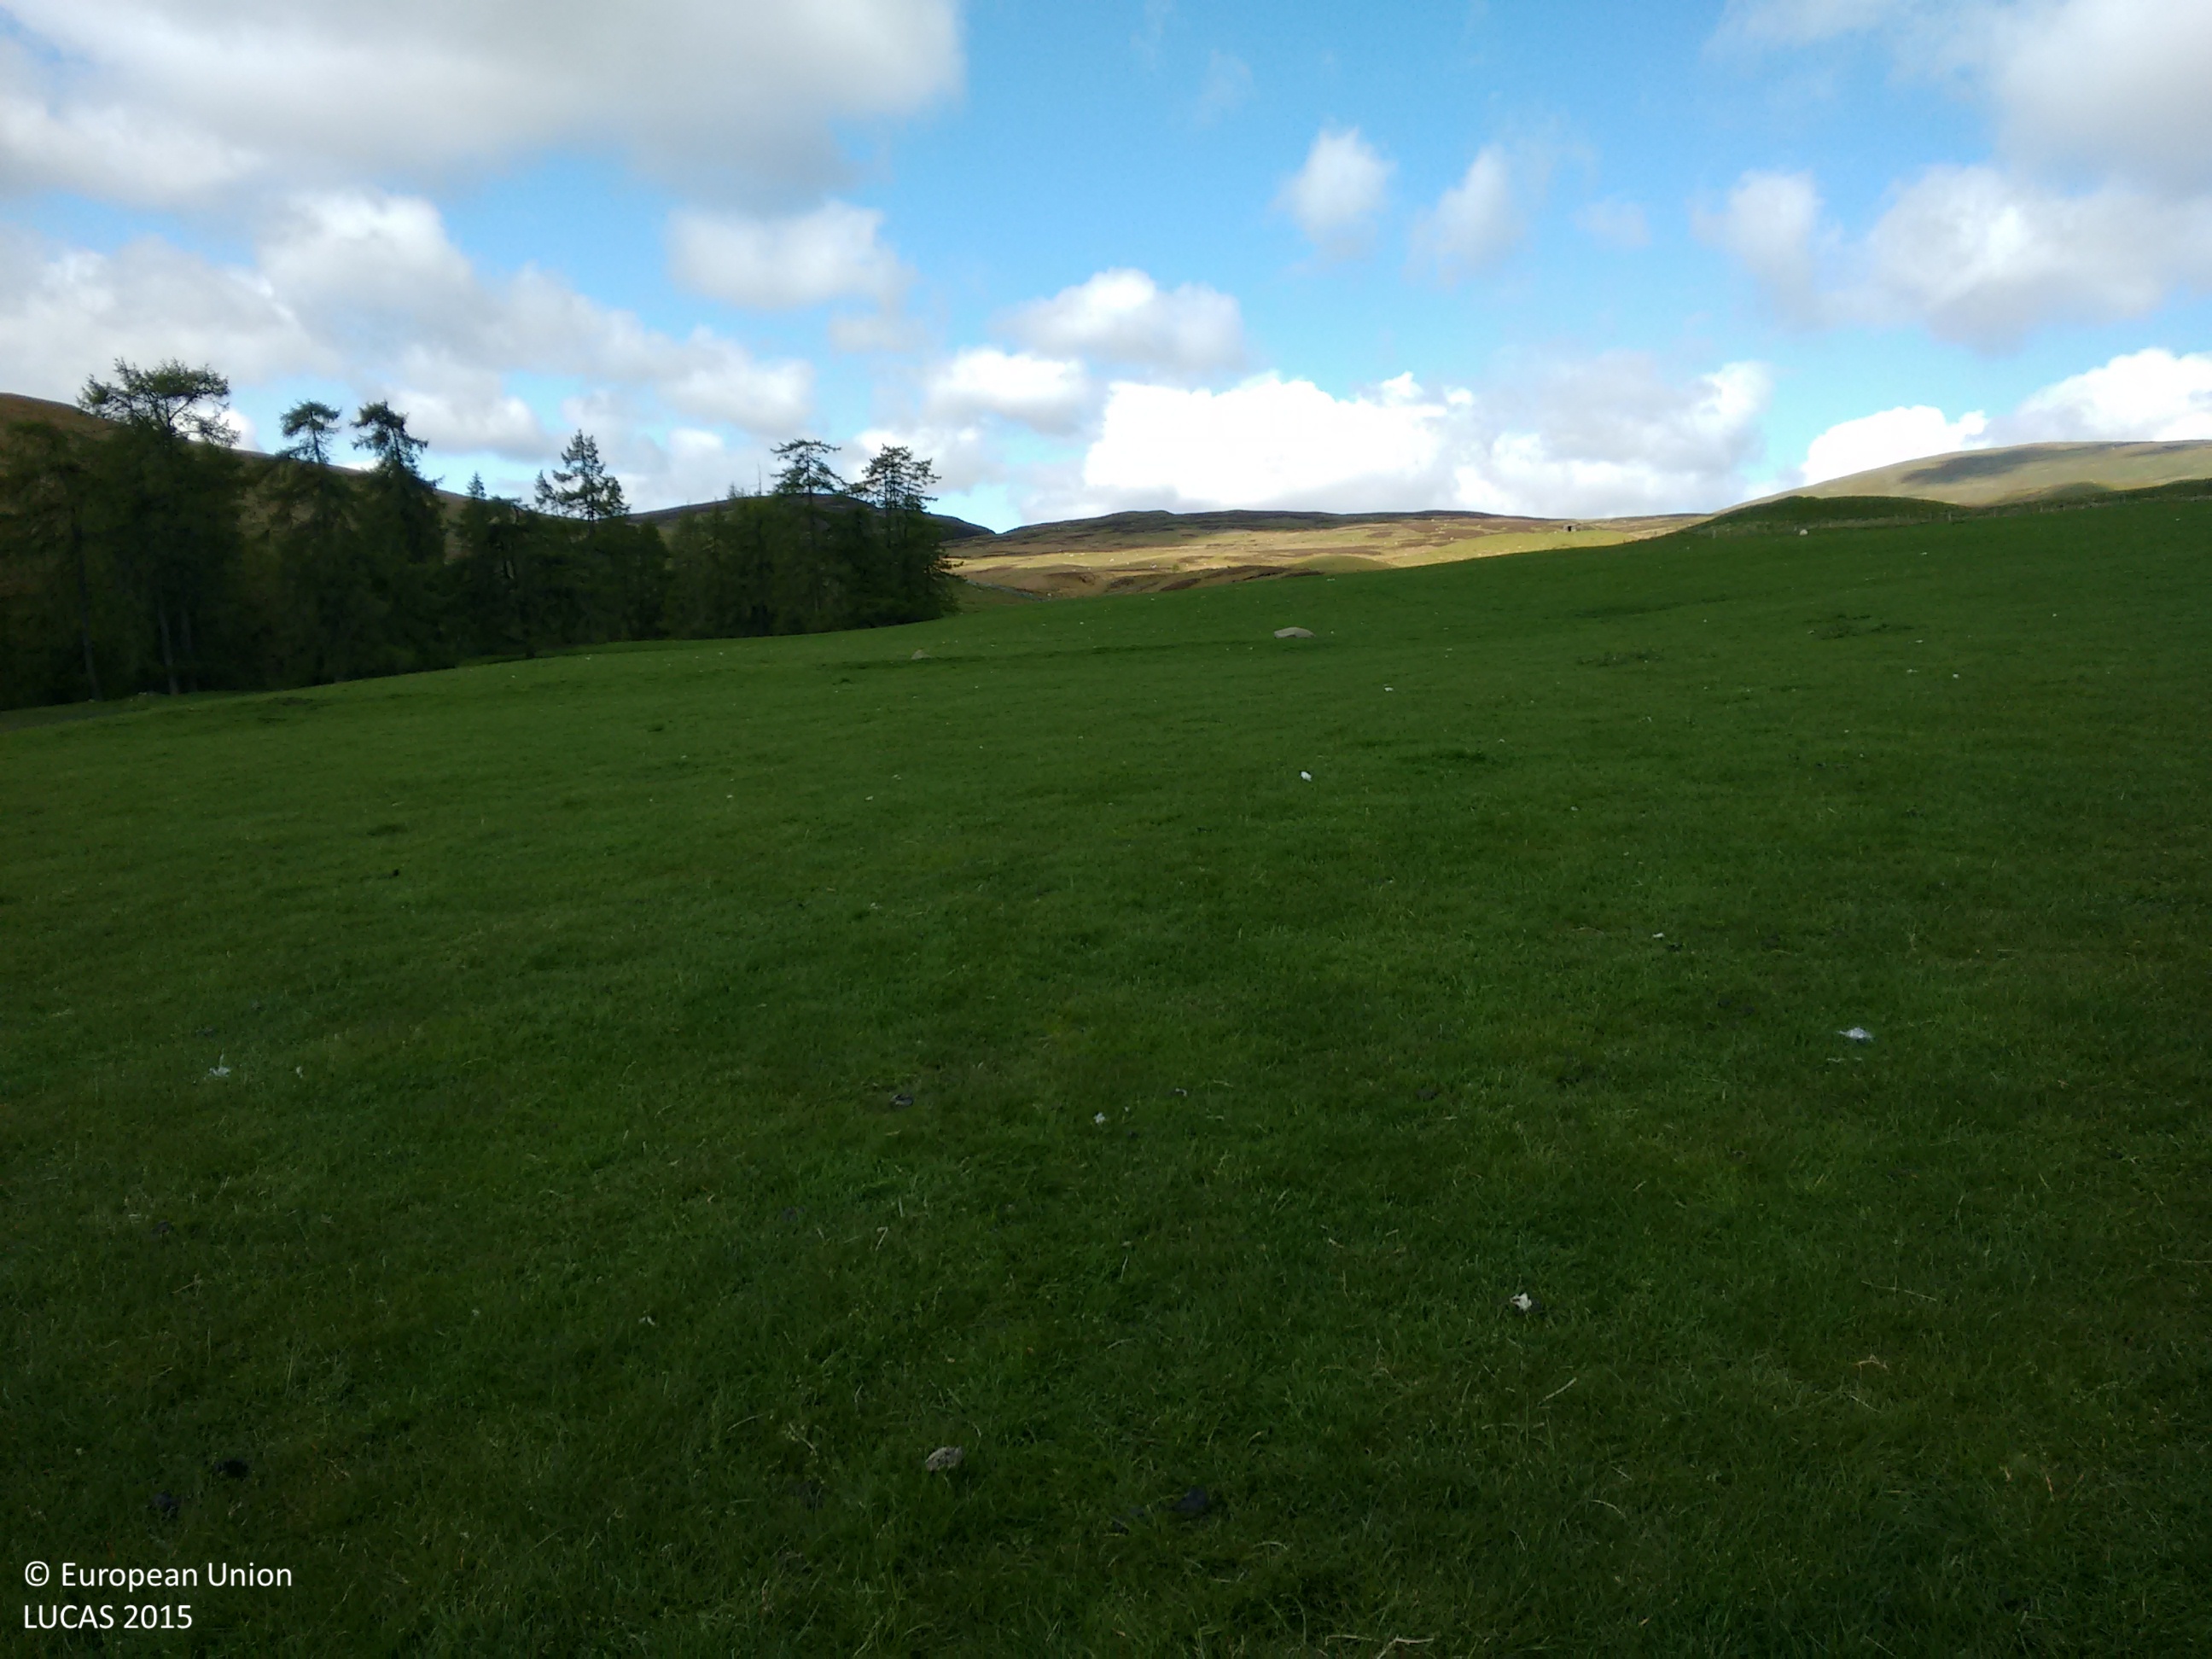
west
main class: Grassland
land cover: Grassland without tree/shrub cover
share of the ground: > 75 %
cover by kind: herbaceous plants 100 %
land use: Agriculture (excluding fallow land and kitchen gardens)
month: June
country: GB
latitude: 56.4226
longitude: -3.8134
